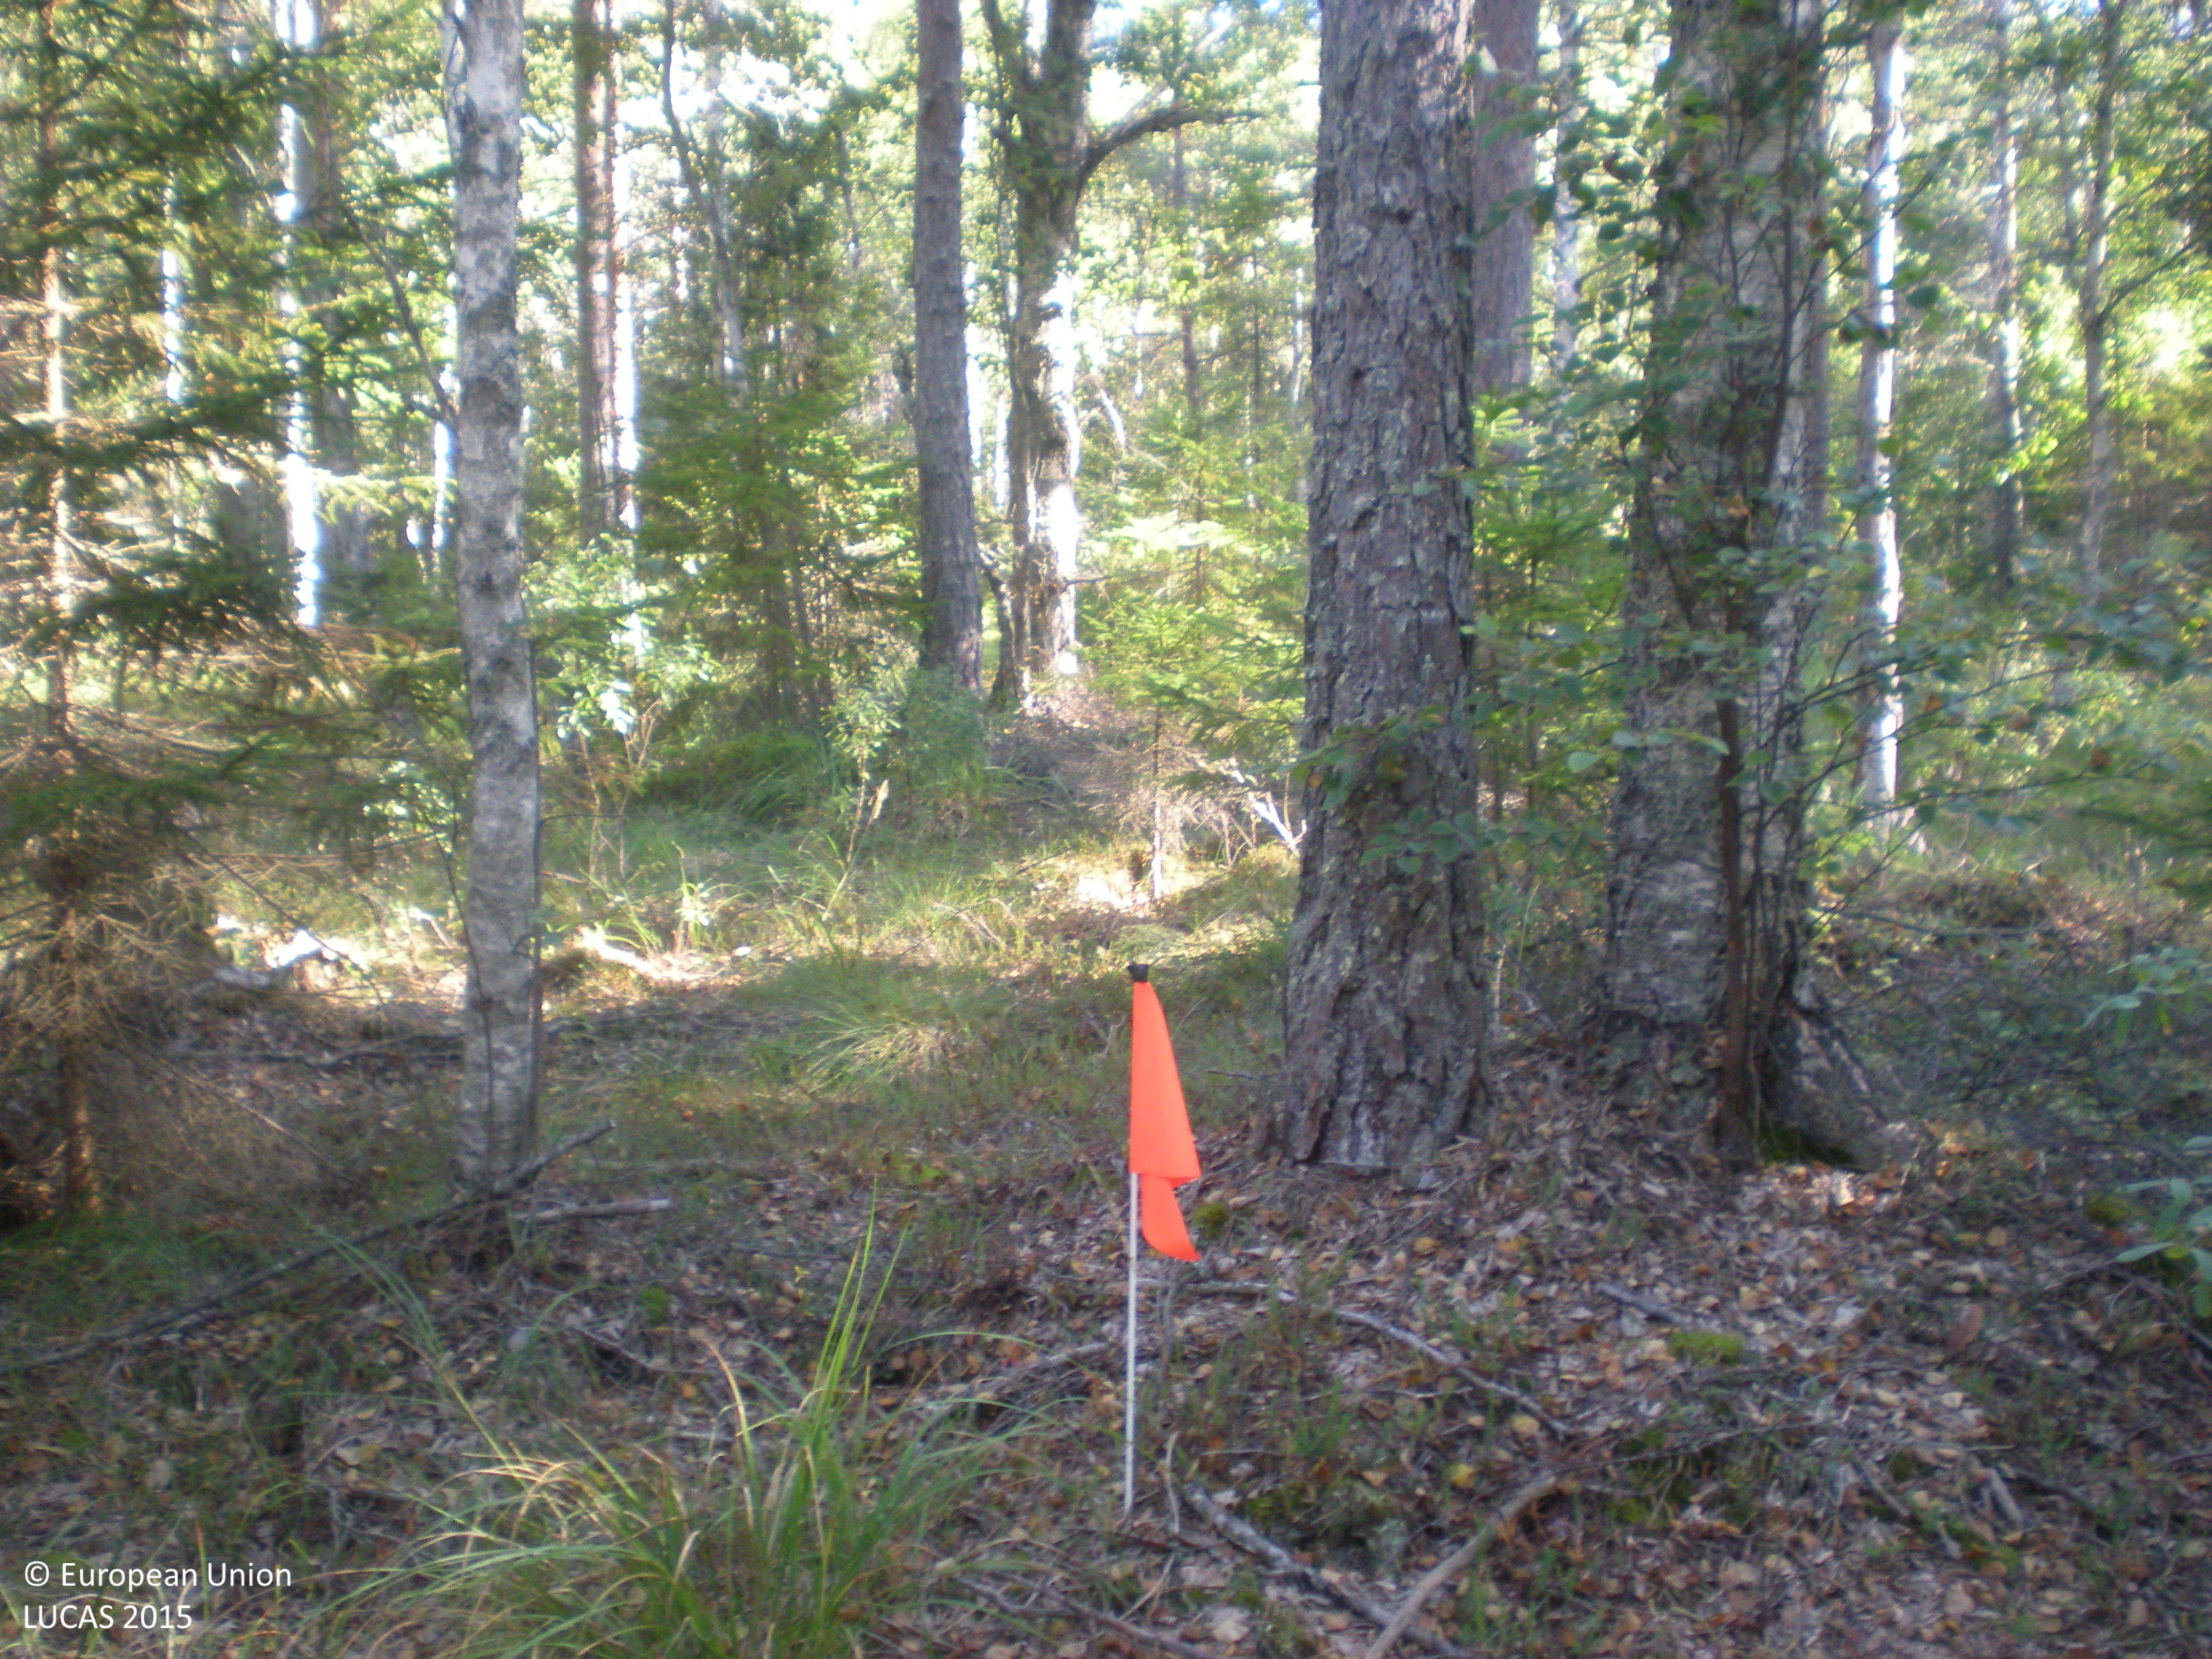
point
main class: Woodland
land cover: Pine dominated mixed woodland
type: boreal forest
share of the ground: 50 - 75 %
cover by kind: coniferous forest trees 40 %, broadleaved forest trees 25 %, herbaceous plants 15 %, lichens and mosses 10 %, shrubs 5 %
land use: Forestry
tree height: > 5 m
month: August
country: SE
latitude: 60.5775
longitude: 17.1614
